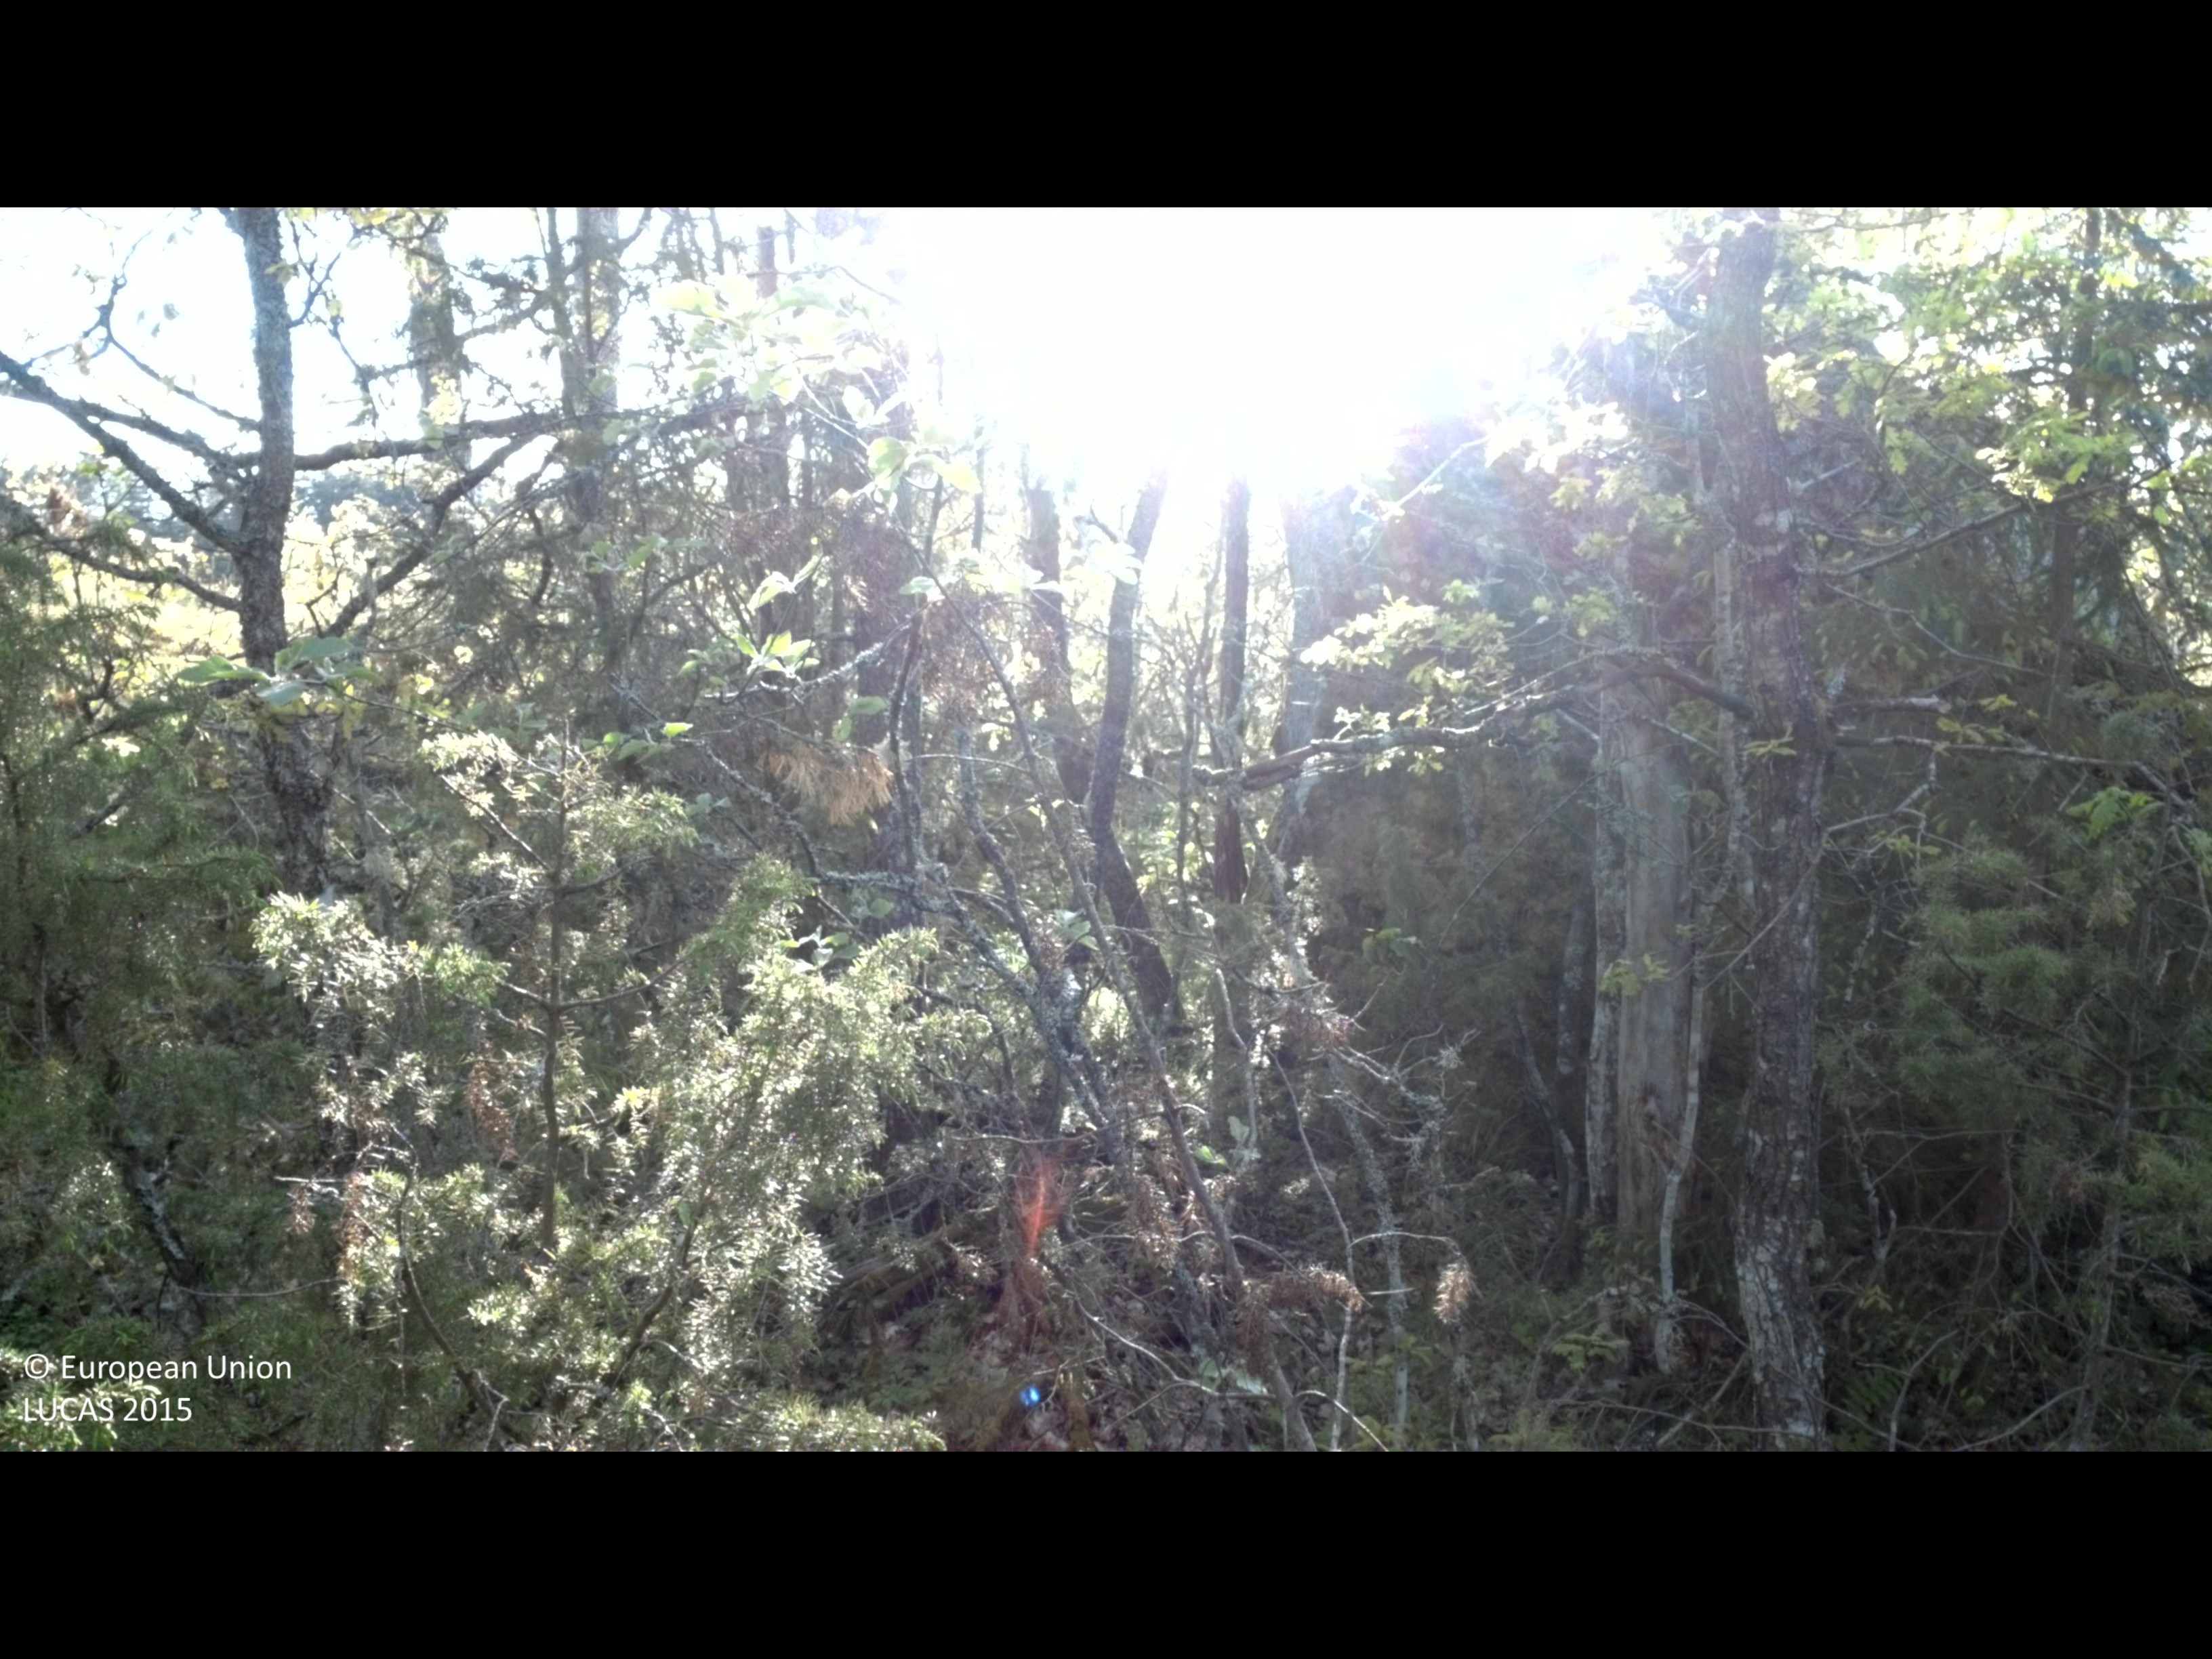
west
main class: Woodland
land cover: Pine dominated mixed woodland
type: boreal forest
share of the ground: > 75 %
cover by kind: broadleaved forest trees 60 %, coniferous forest trees 20 %, herbaceous plants 15 %, shrubs 5 %
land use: Forestry
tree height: > 5 m
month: May
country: SE
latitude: 57.3922
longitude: 16.1713
